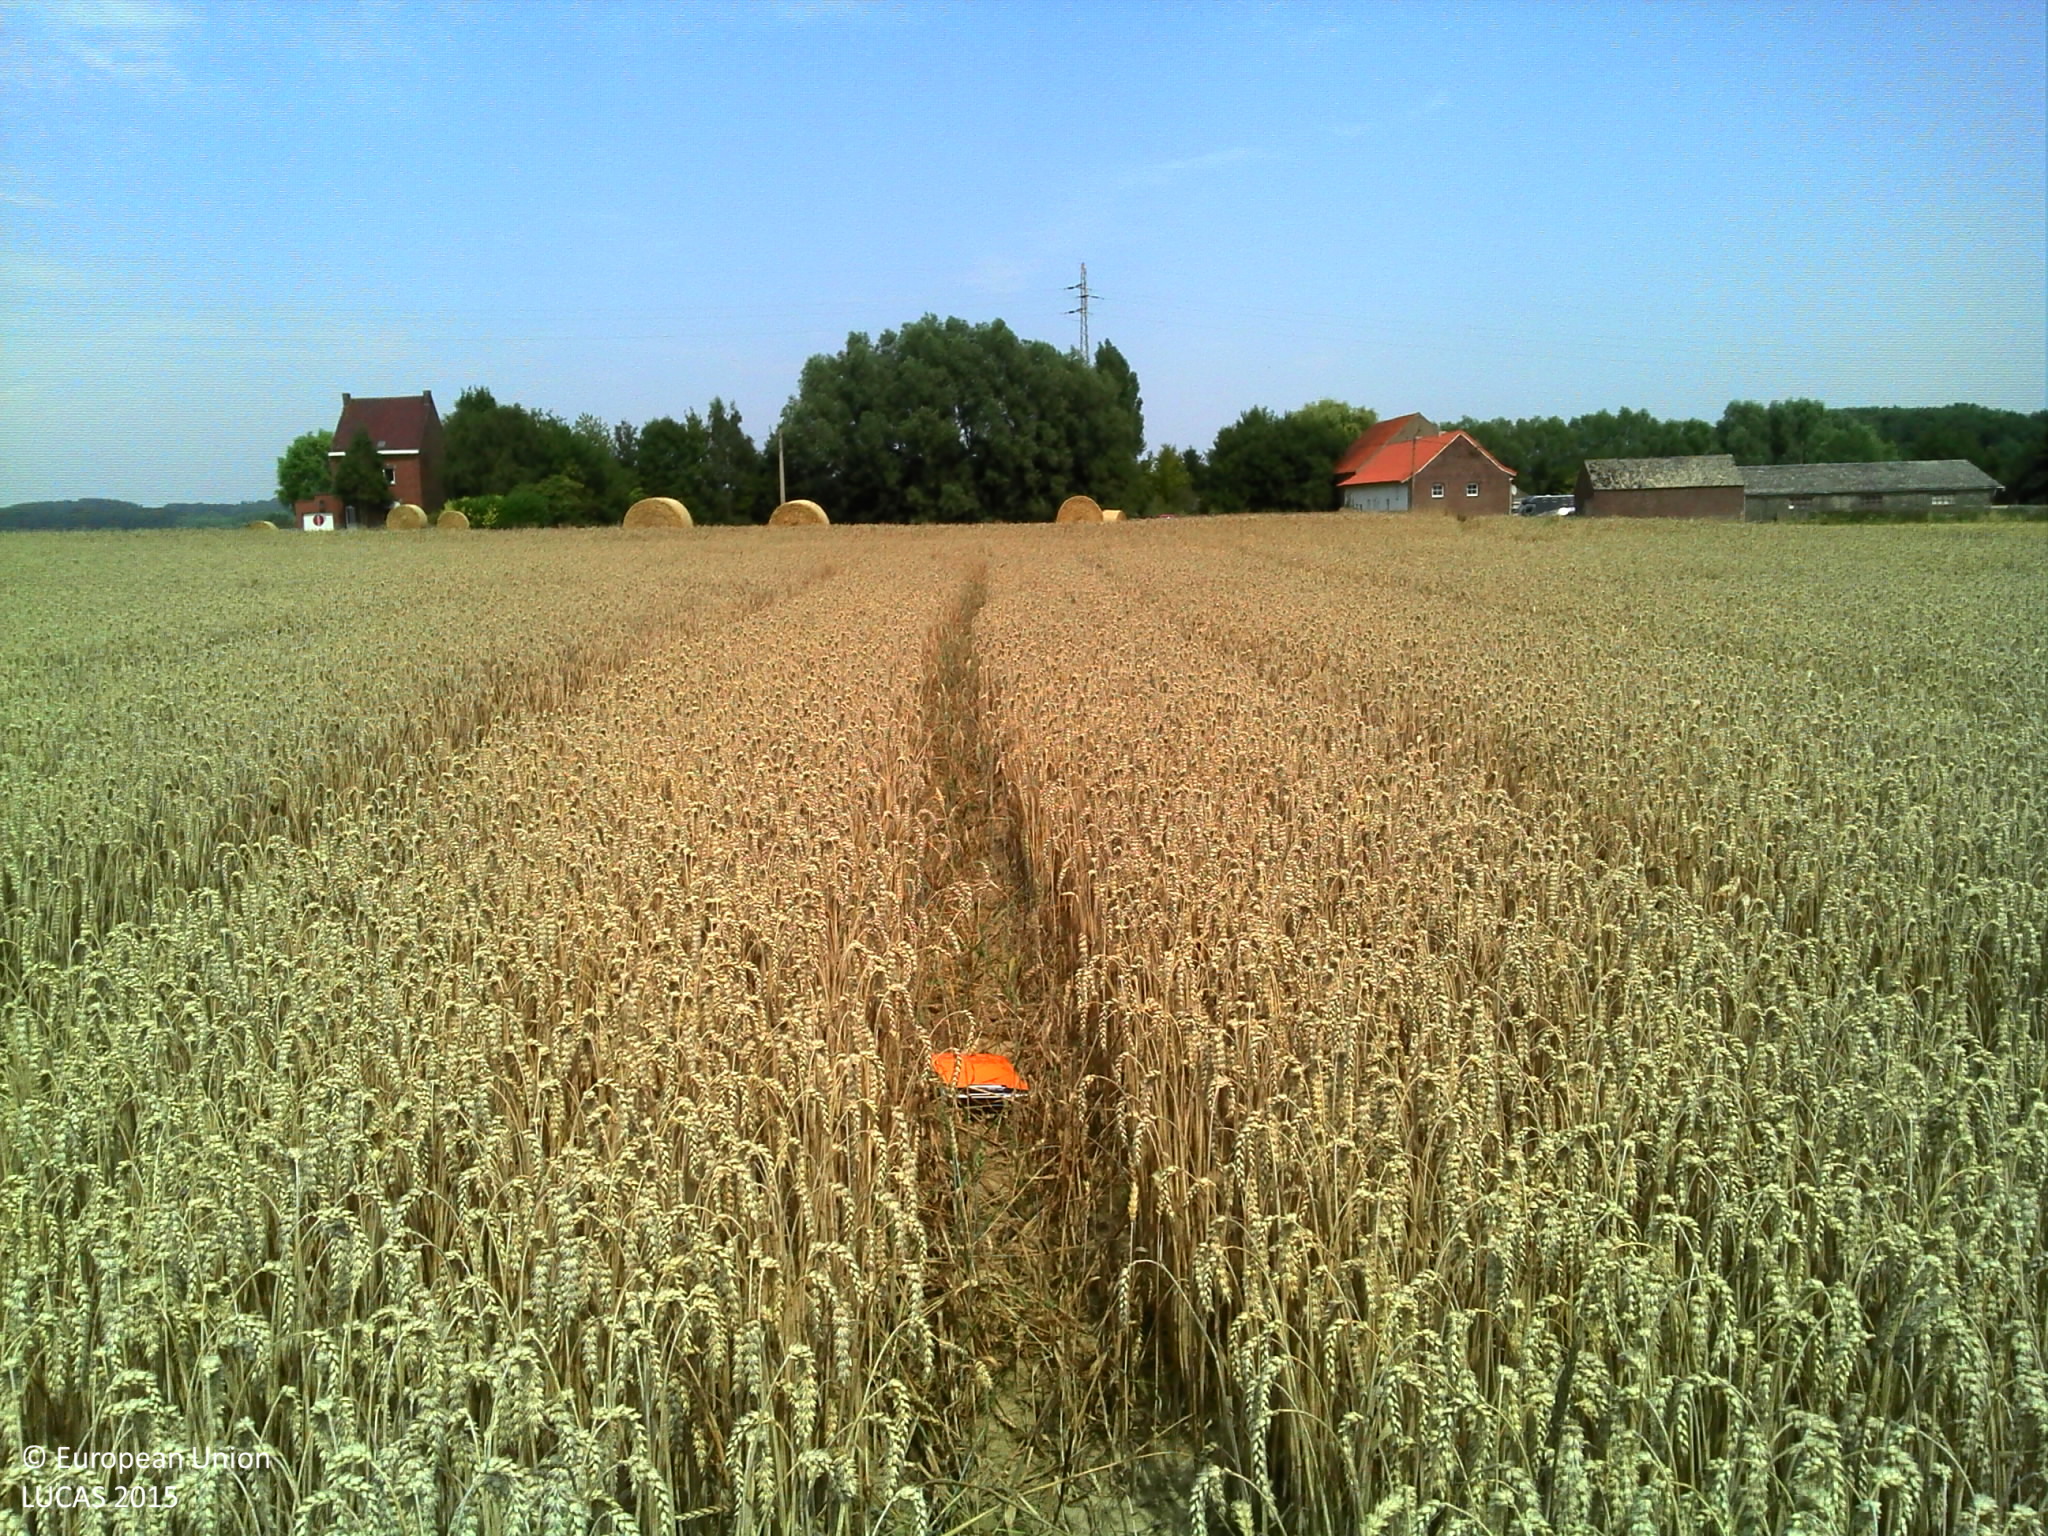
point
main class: Cropland
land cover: Common wheat
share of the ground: > 75 %
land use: Agriculture (excluding fallow land and kitchen gardens)
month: August
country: BE
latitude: 50.7236
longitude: 3.8884
